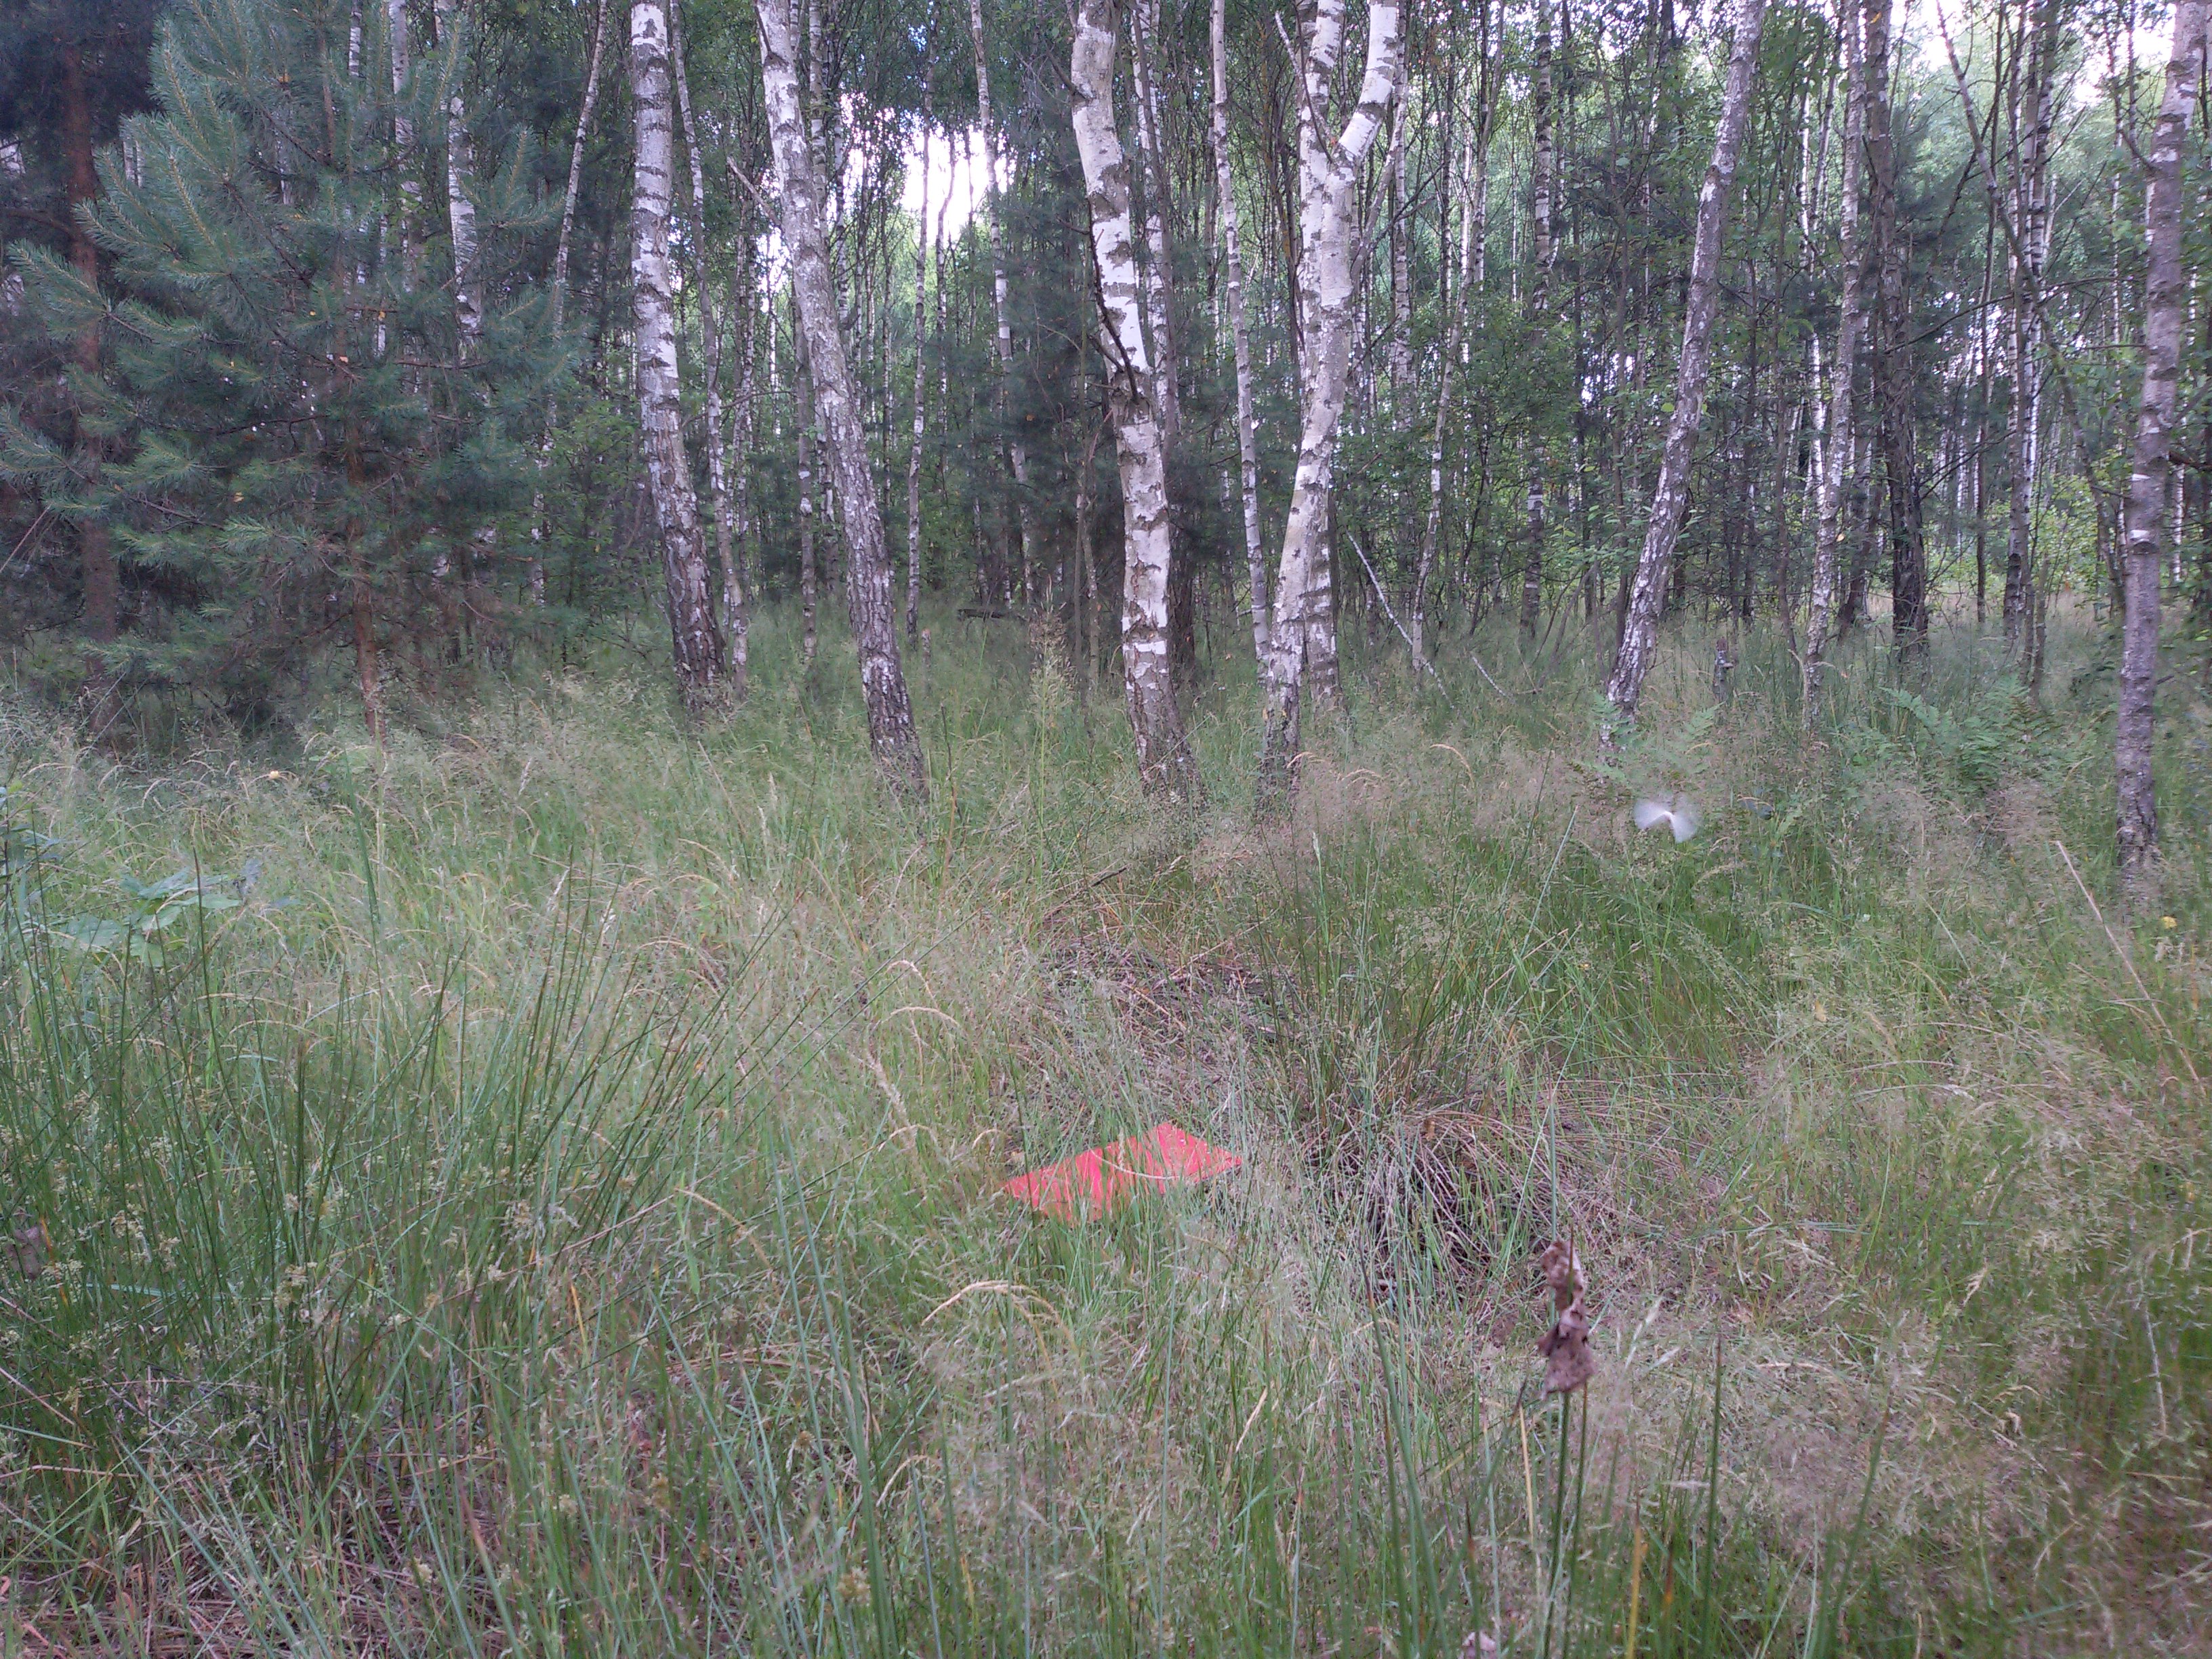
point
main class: Woodland
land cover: Broadleaved woodland
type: mesophytic deciduous forest
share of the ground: > 75 %
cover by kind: broadleaved forest trees 85 %, herbaceous plants 10 %, shrubs 5 %
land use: Forestry
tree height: > 5 m
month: June
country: PL
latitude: 51.8513
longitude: 23.0697
